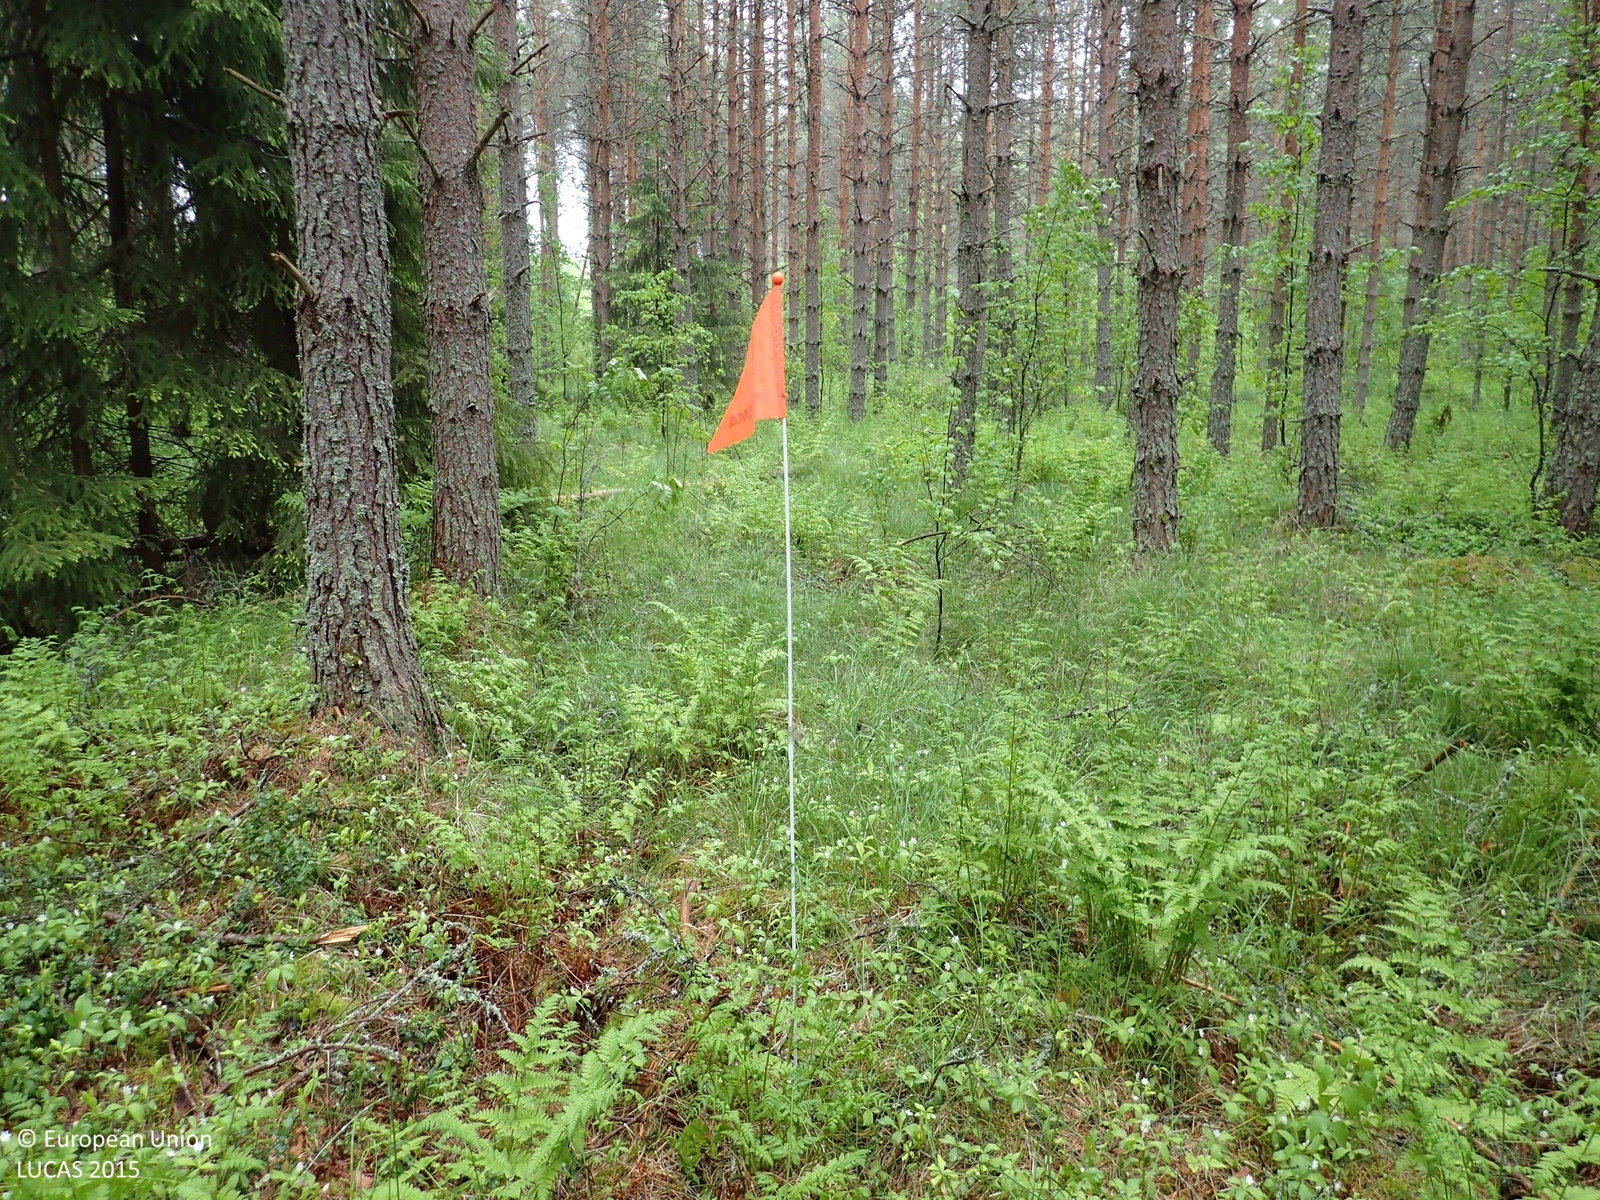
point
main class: Woodland
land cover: Pine dominated coniferous woodland
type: boreal forest
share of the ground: > 75 %
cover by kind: coniferous forest trees 70 %, herbaceous plants 25 %, broadleaved forest trees 5 %
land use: Forestry
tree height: > 5 m
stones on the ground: < 10 %
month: June
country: FI
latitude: 62.4615
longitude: 22.6405
